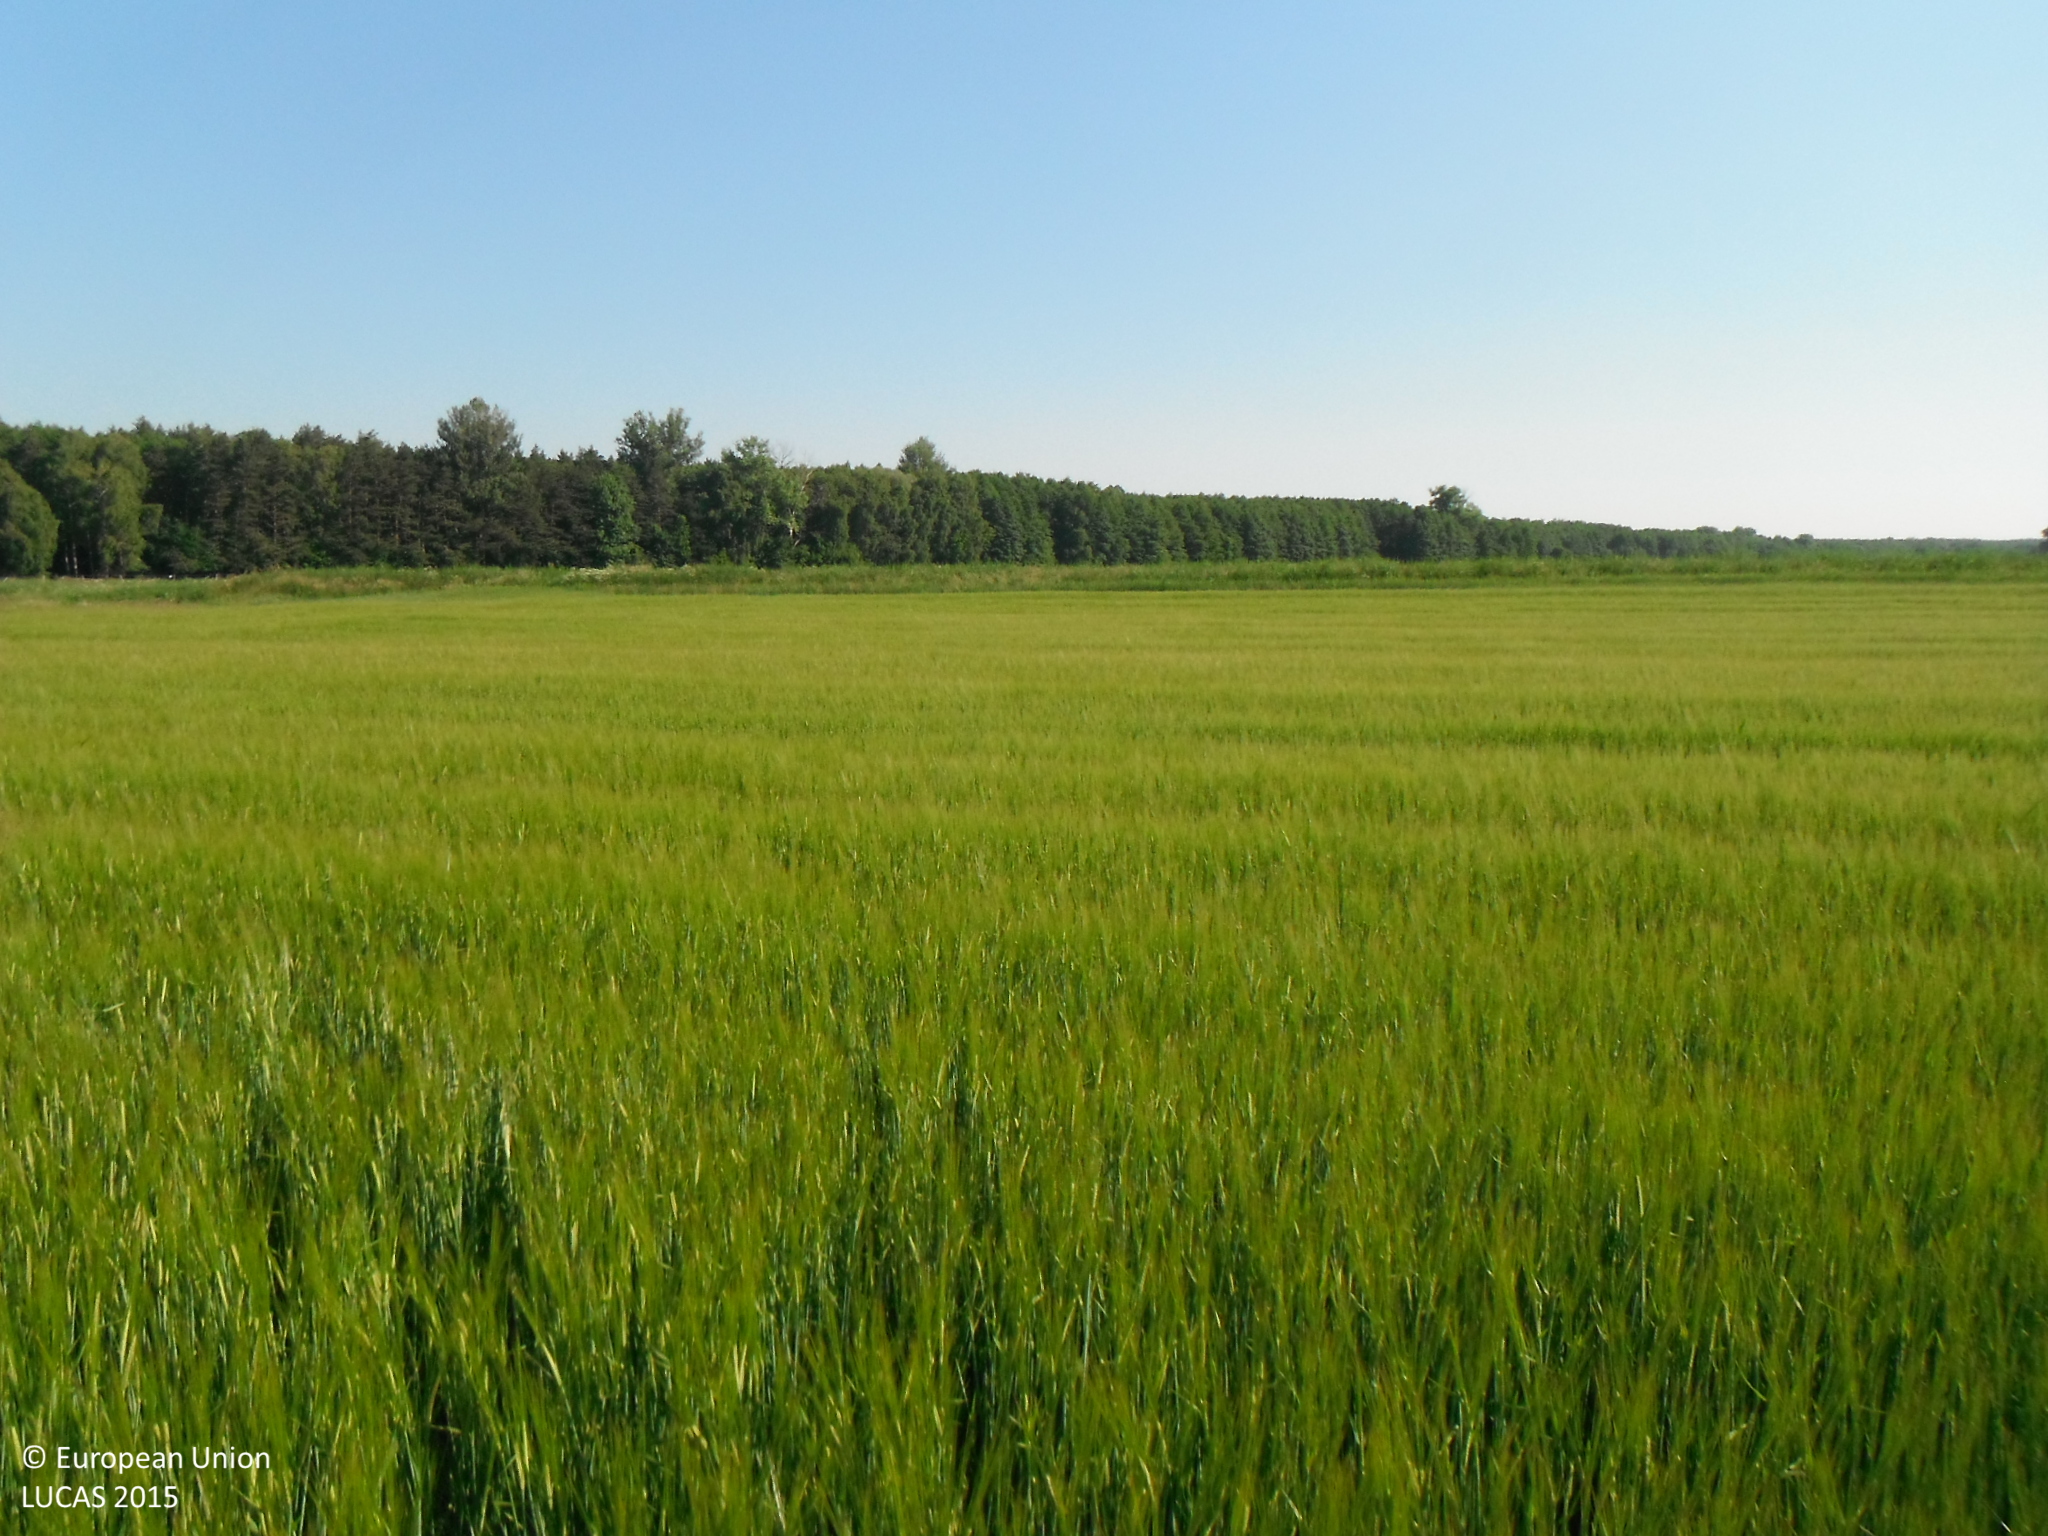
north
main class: Cropland
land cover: Barley
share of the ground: > 75 %
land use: Agriculture (excluding fallow land and kitchen gardens)
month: June
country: SK
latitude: 48.5425
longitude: 17.2833
